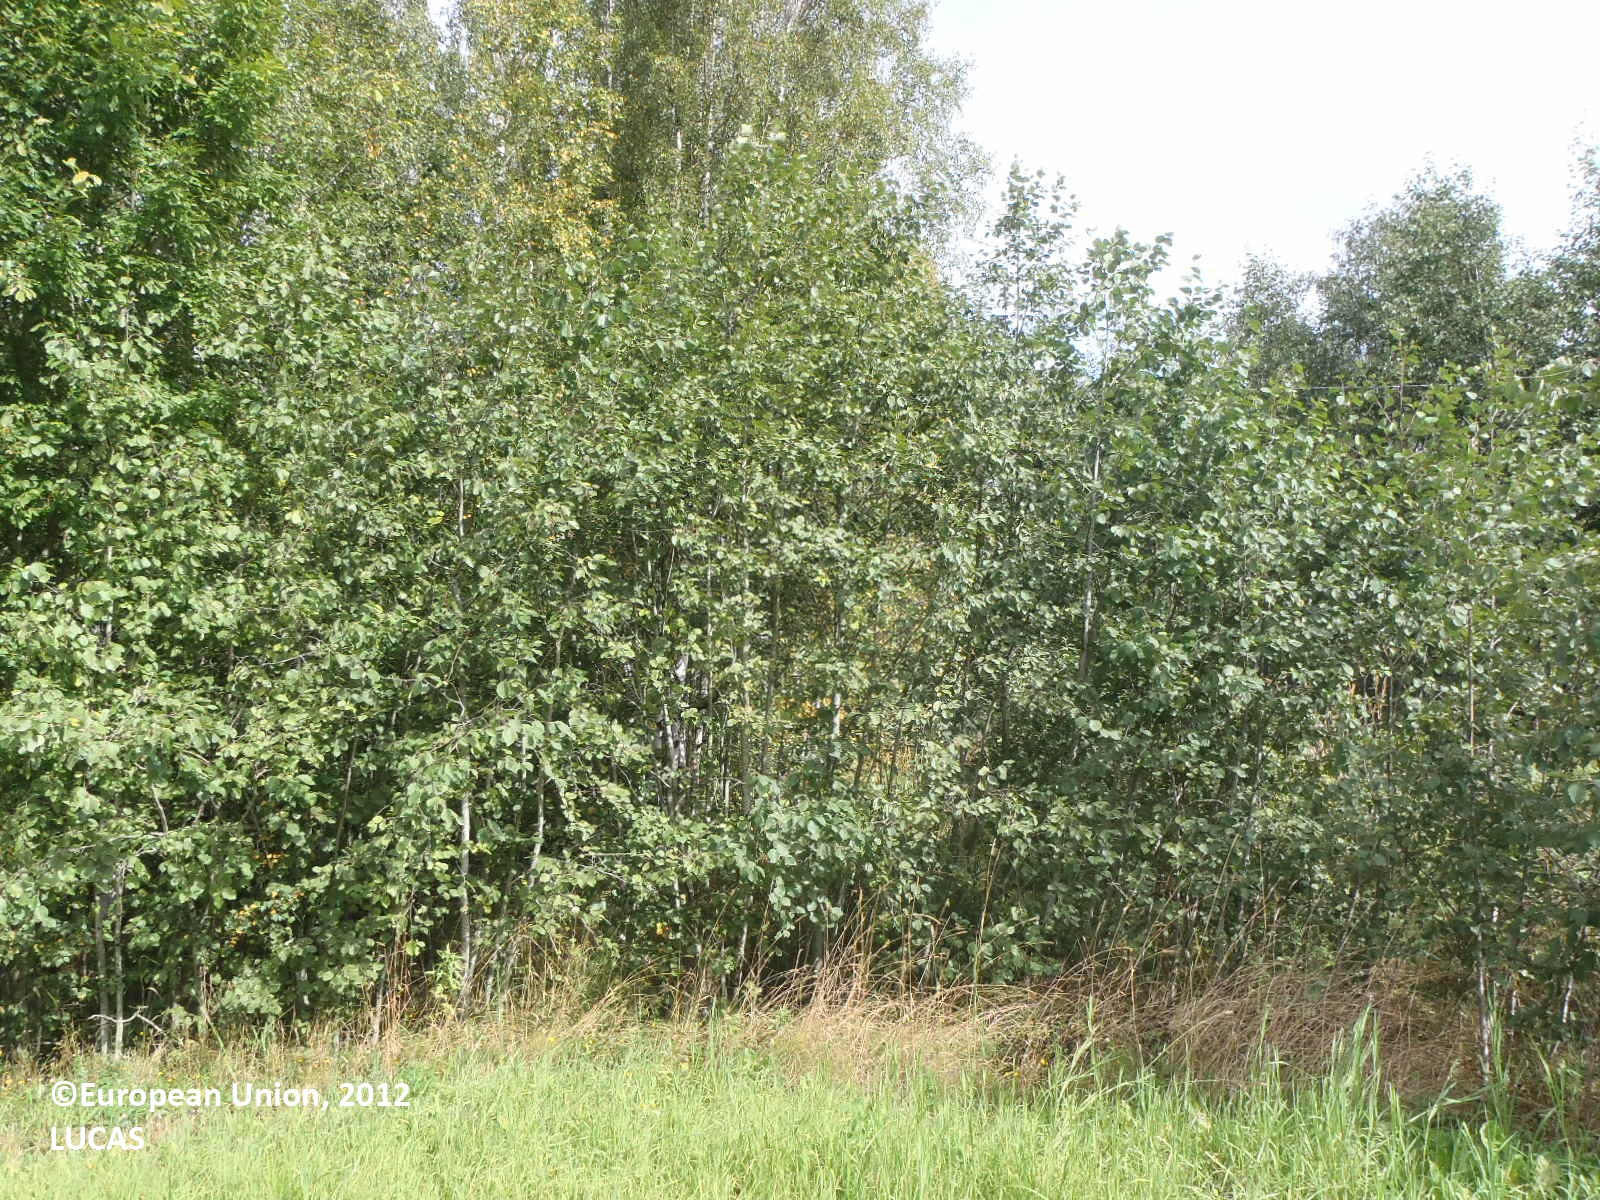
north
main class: Cropland
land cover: Temporary grasslands
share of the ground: > 75 %
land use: Agriculture (excluding fallow land and kitchen gardens)
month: September
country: FI
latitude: 61.0668
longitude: 22.6881
